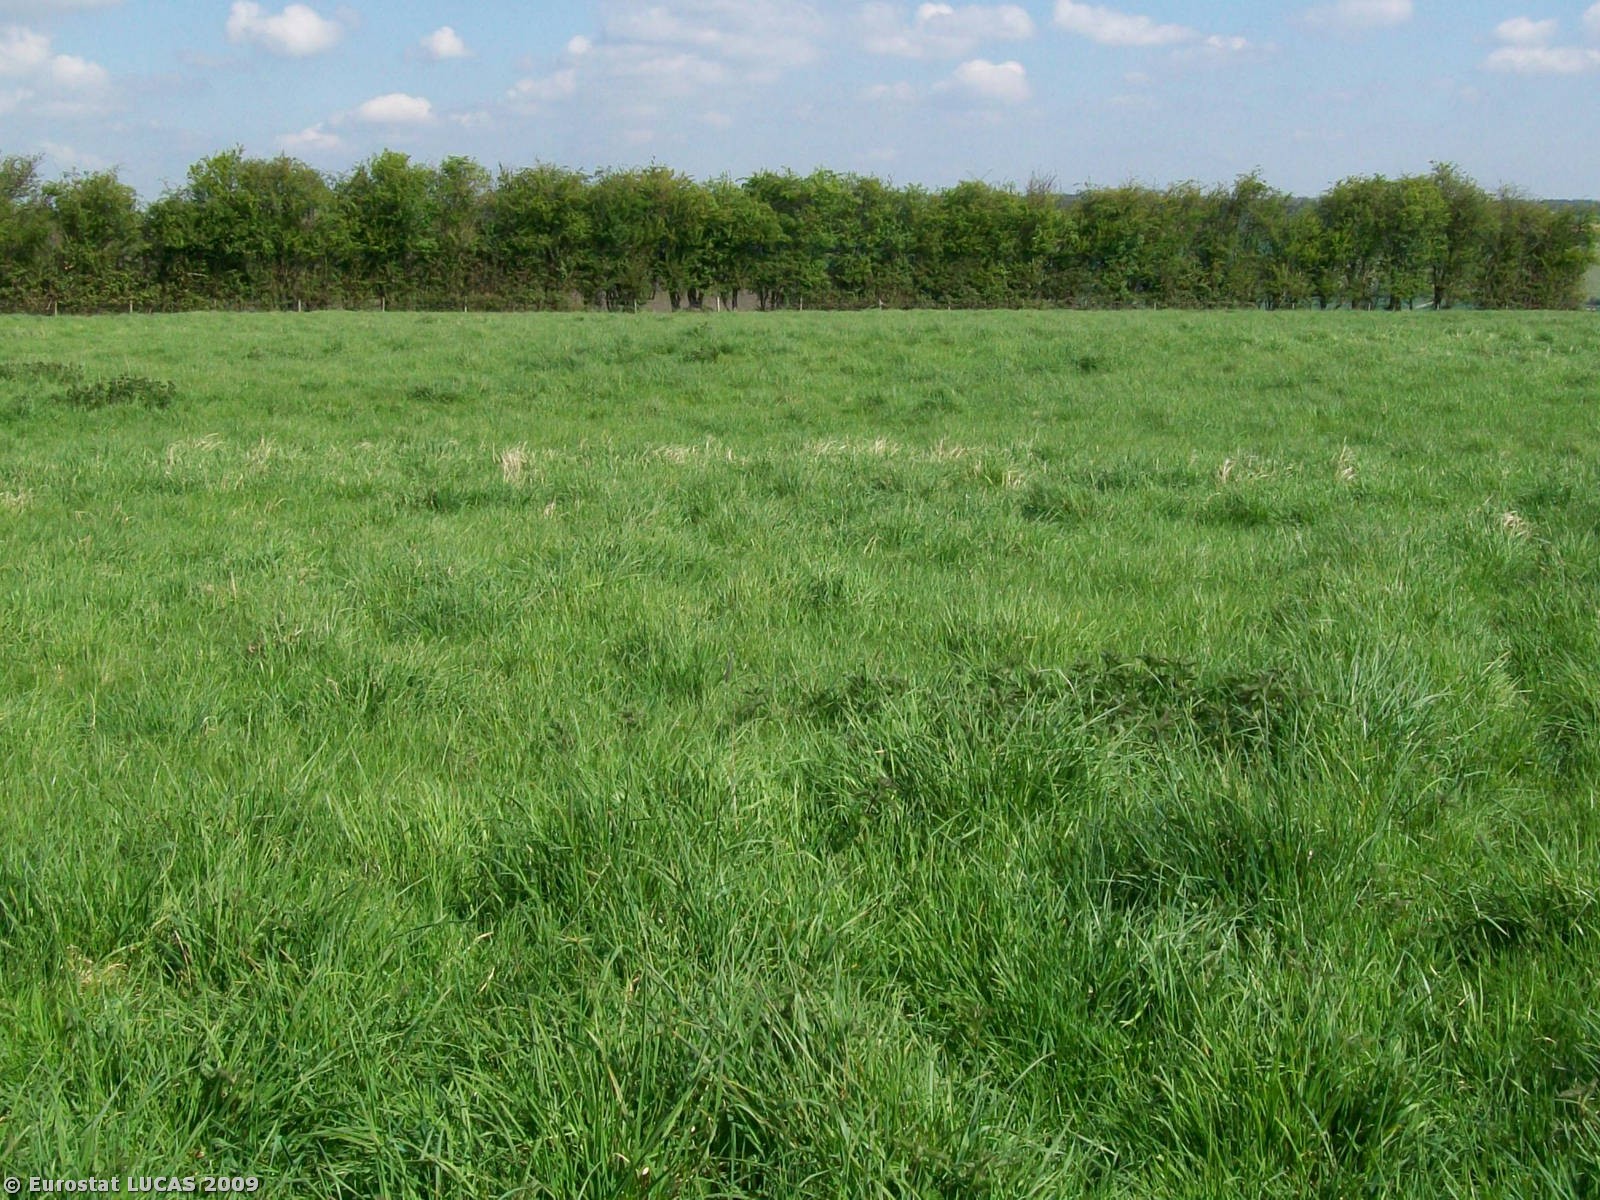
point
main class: Grassland
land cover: Grassland without tree/shrub cover
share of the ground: > 75 %
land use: Agriculture (excluding fallow land and kitchen gardens)
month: April
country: GB
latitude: 51.8148
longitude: -0.5558
